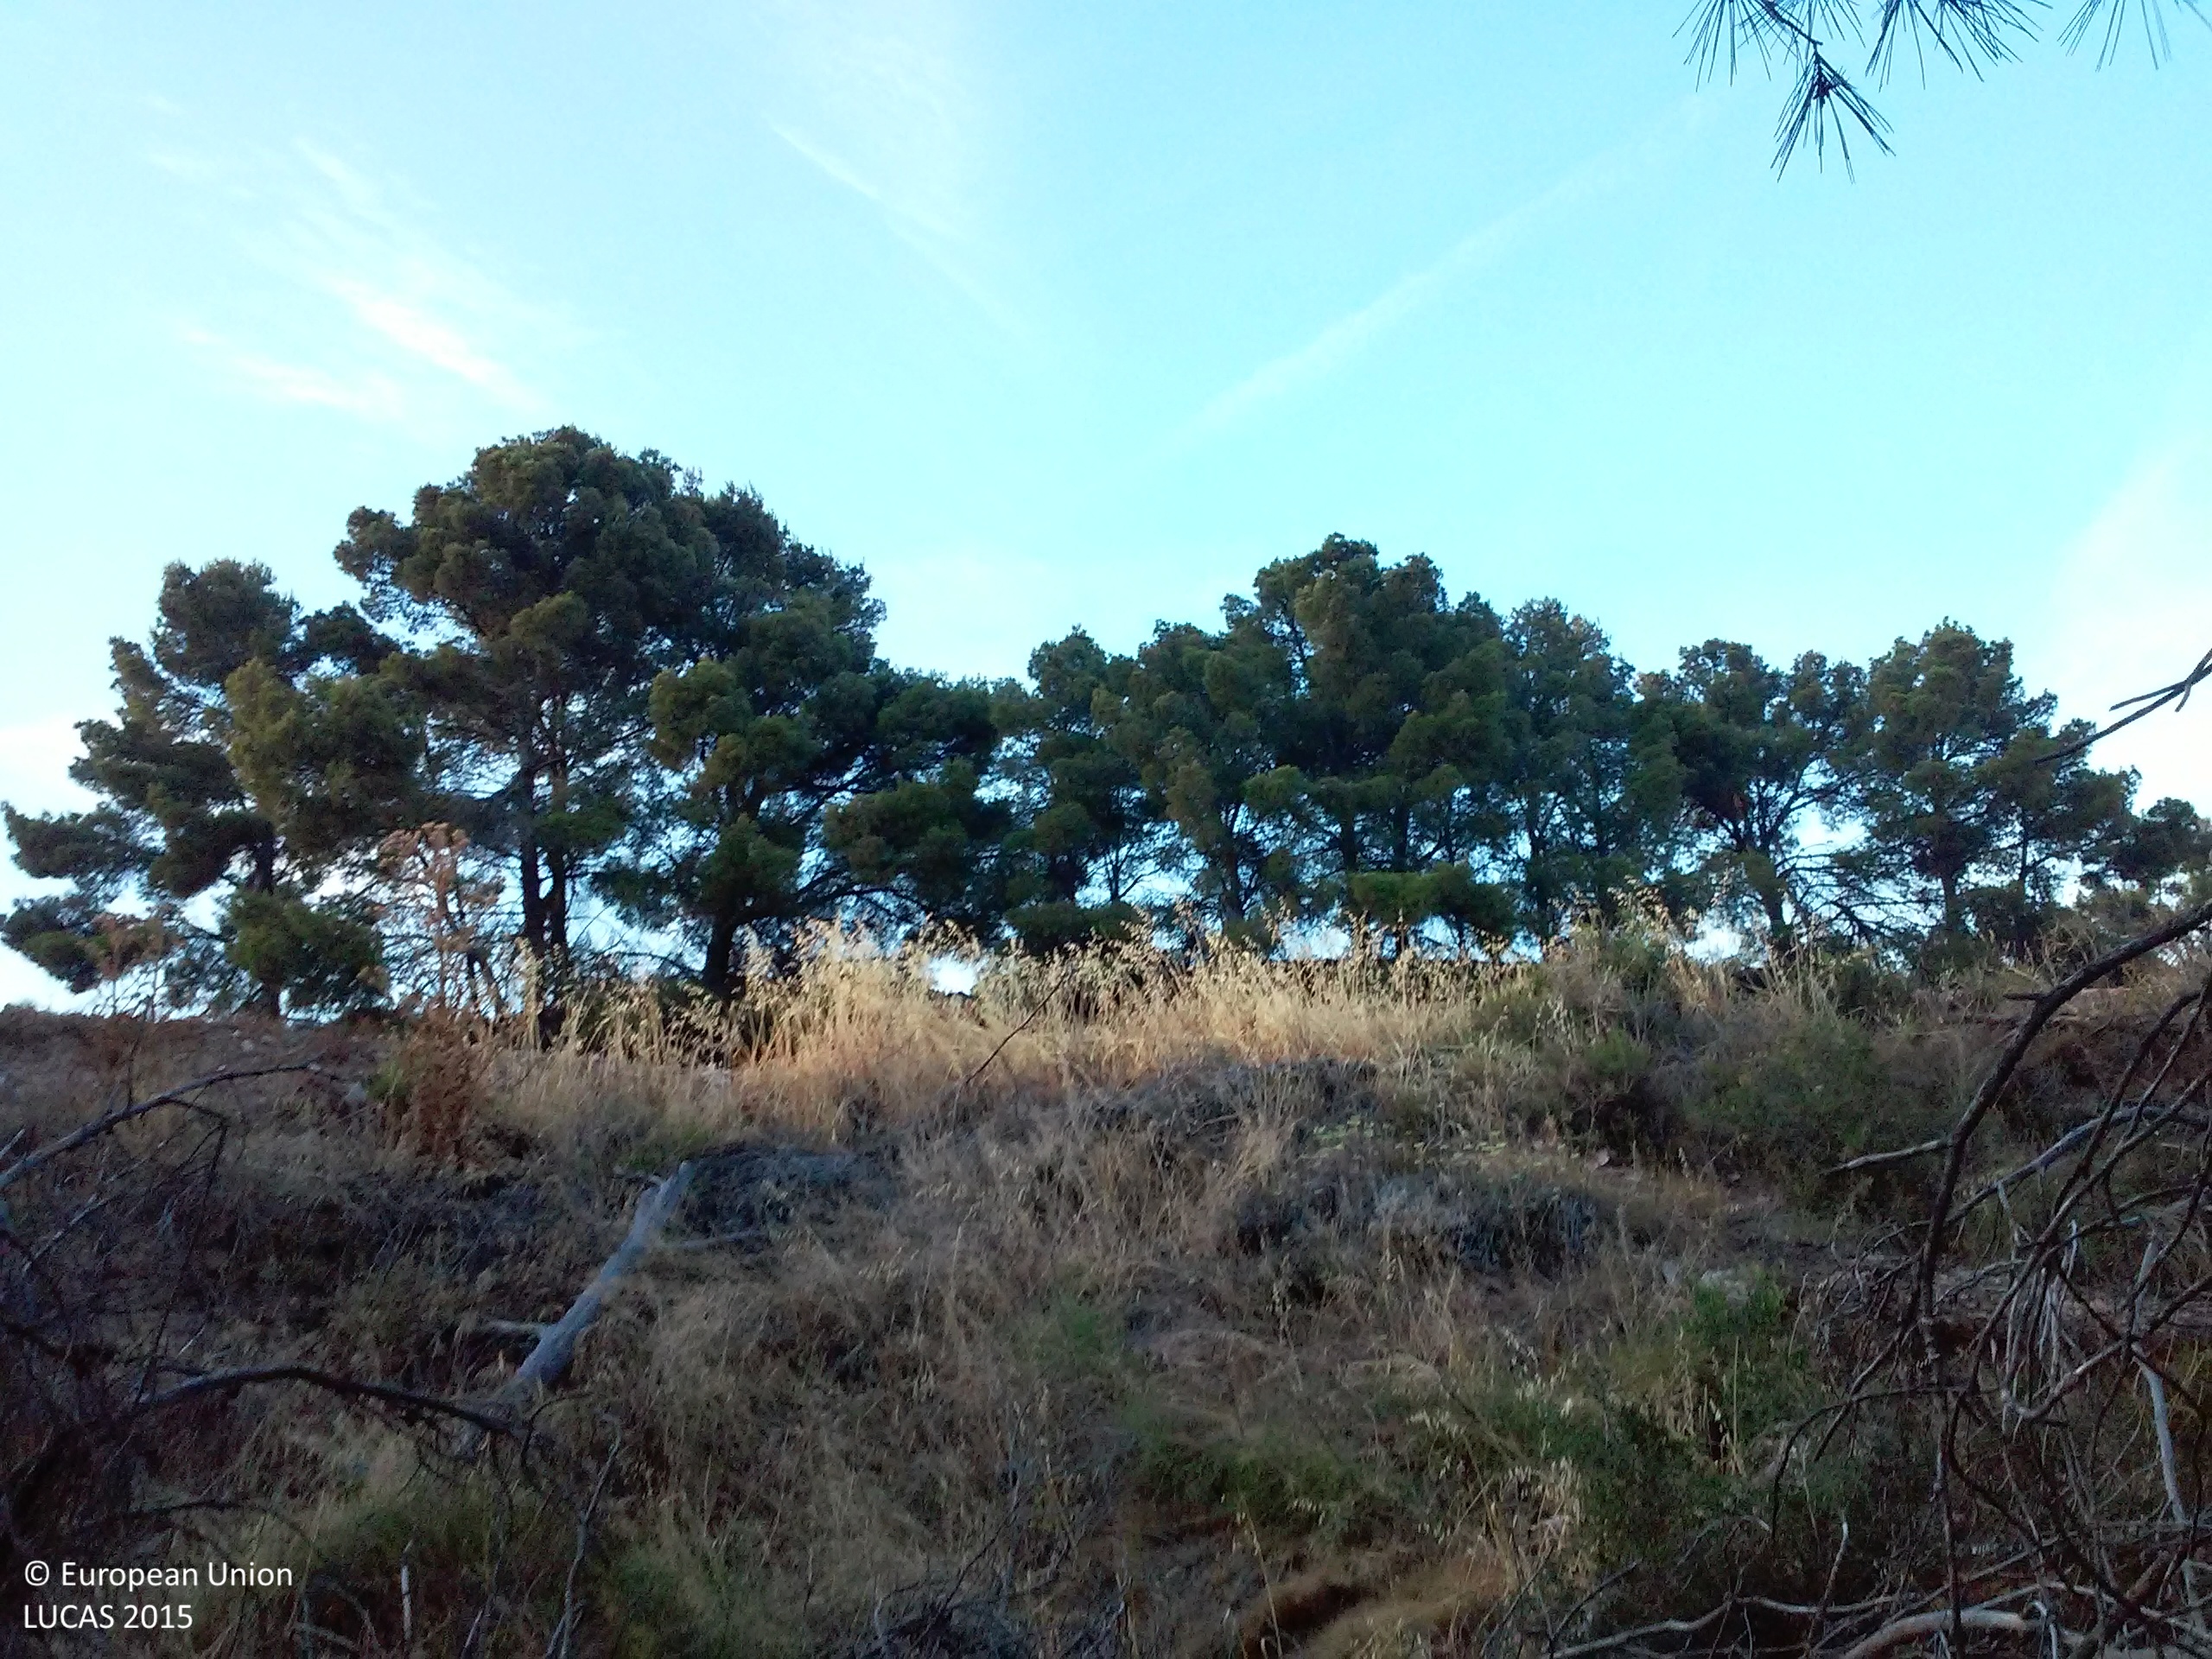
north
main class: Woodland
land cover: Pine dominated coniferous woodland
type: coniferous forest of the mediterranean region
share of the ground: 25 - 50 %
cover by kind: coniferous forest trees 60 %, shrubs 15 %, herbaceous plants 15 %, lichens and mosses 10 %
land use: Semi-natural and natural areas not in use
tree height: > 5 m
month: July
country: ES
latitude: 41.5980
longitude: 1.1959
